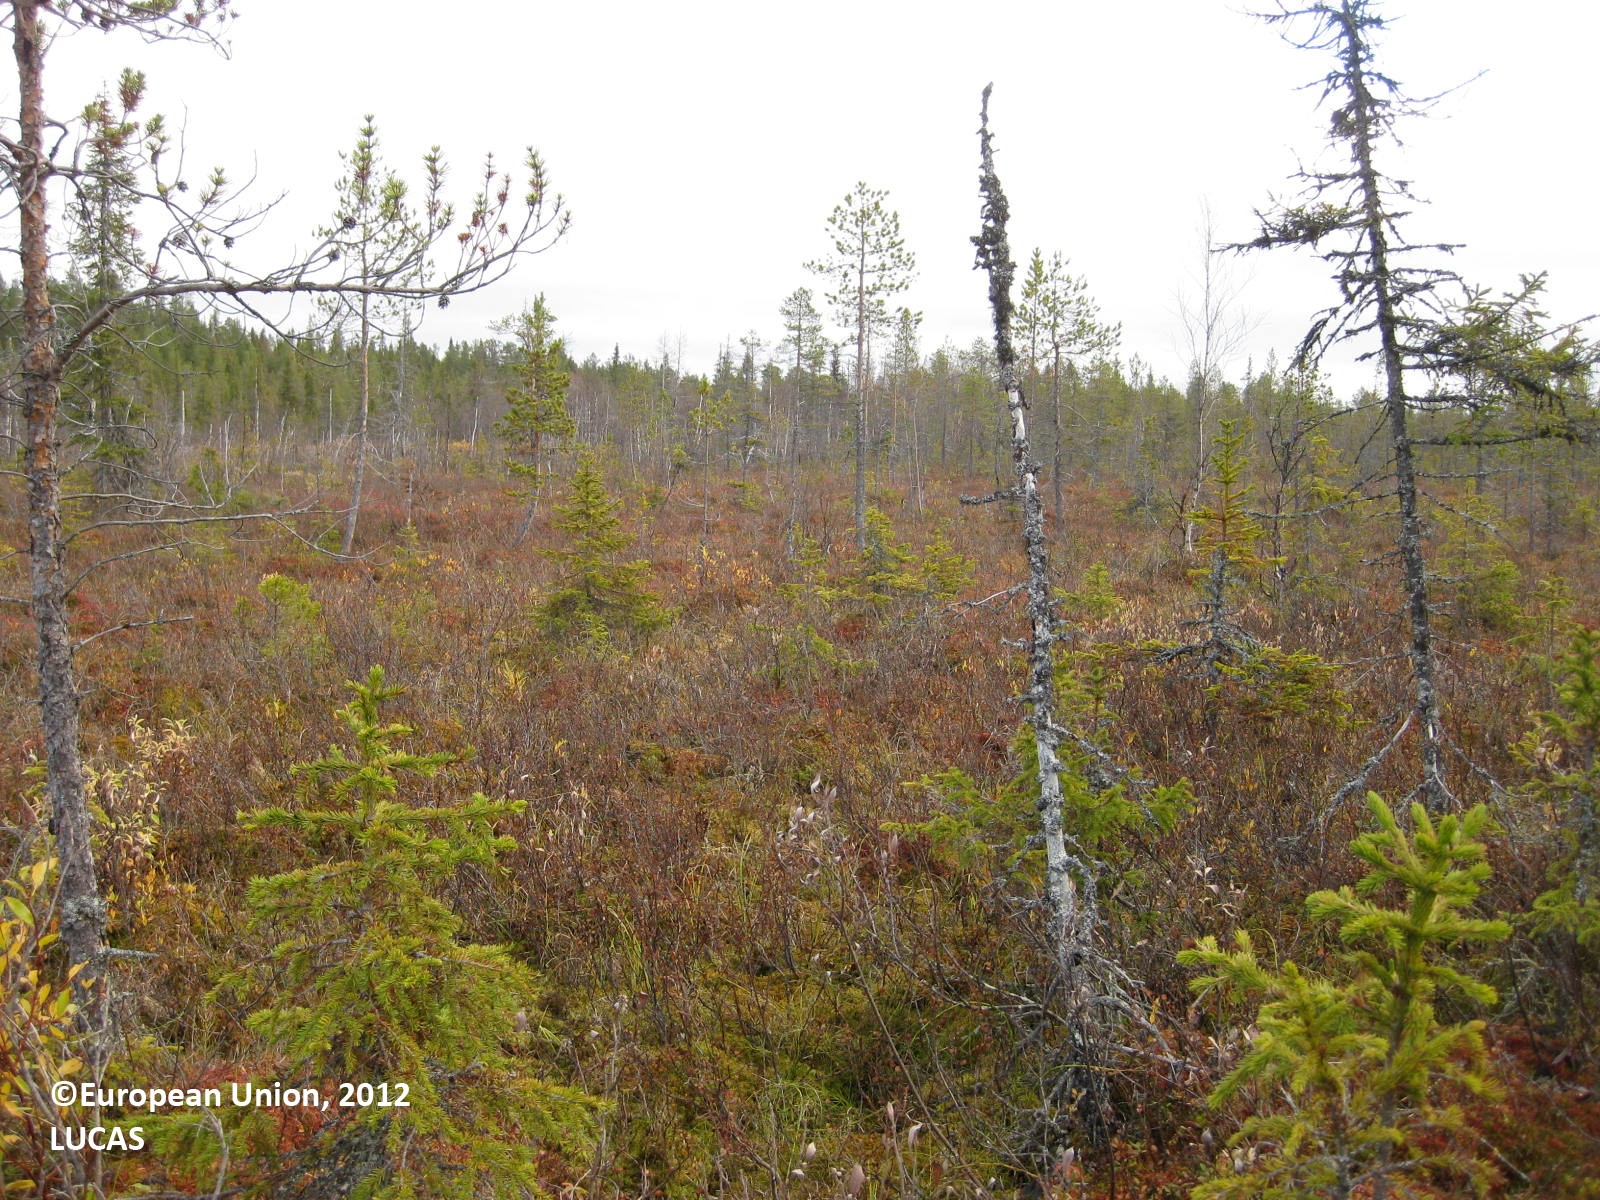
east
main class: Woodland
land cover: Pine dominated mixed woodland
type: boreal forest
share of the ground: 25 - 50 %
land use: Semi-natural and natural areas not in use
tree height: > 5 m
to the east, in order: Pine dominated mixed woodland; Shrubland without tree cover; Other mixed woodland; Pine dominated mixed woodland; Peatbogs; Pine dominated mixed woodland
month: September
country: FI
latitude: 67.9908
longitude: 23.6163
